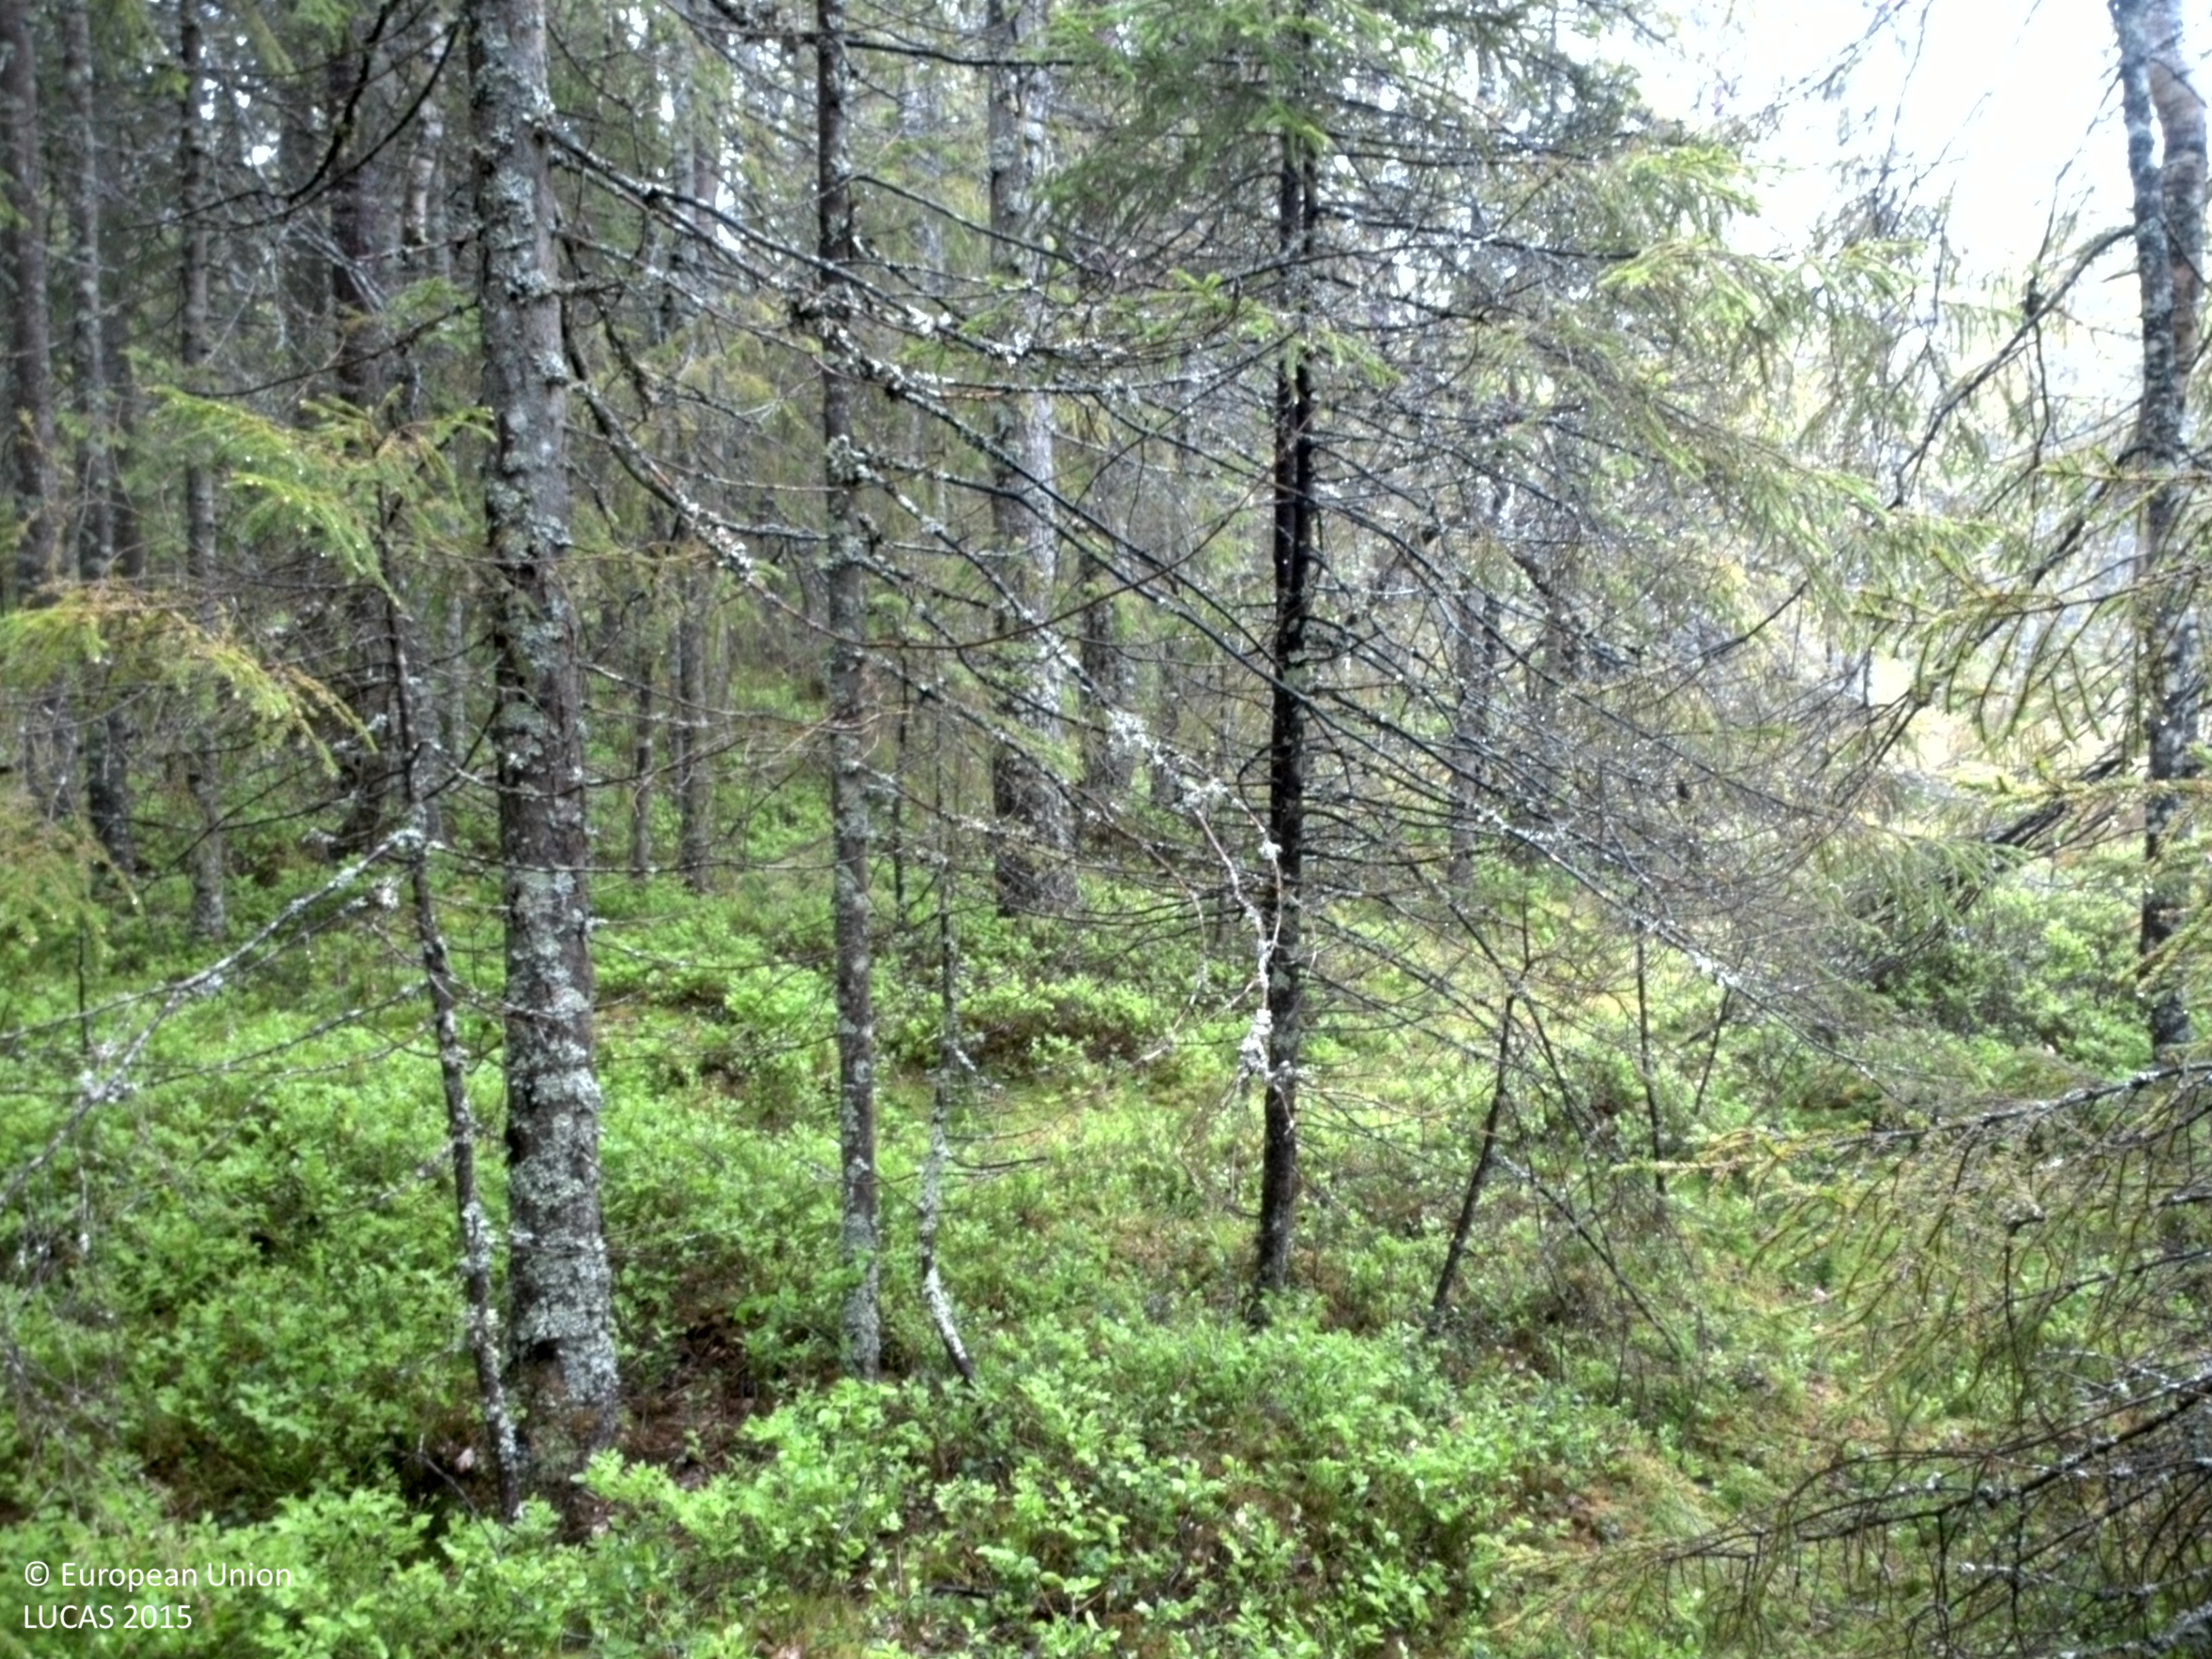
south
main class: Woodland
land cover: Spruce dominated coniferous woodland
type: boreal forest
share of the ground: 50 - 75 %
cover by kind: coniferous forest trees 65 %, shrubs 15 %, lichens and mosses 15 %, broadleaved forest trees 5 %
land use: Forestry
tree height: > 5 m
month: June
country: SE
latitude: 59.6754
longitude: 12.3199
